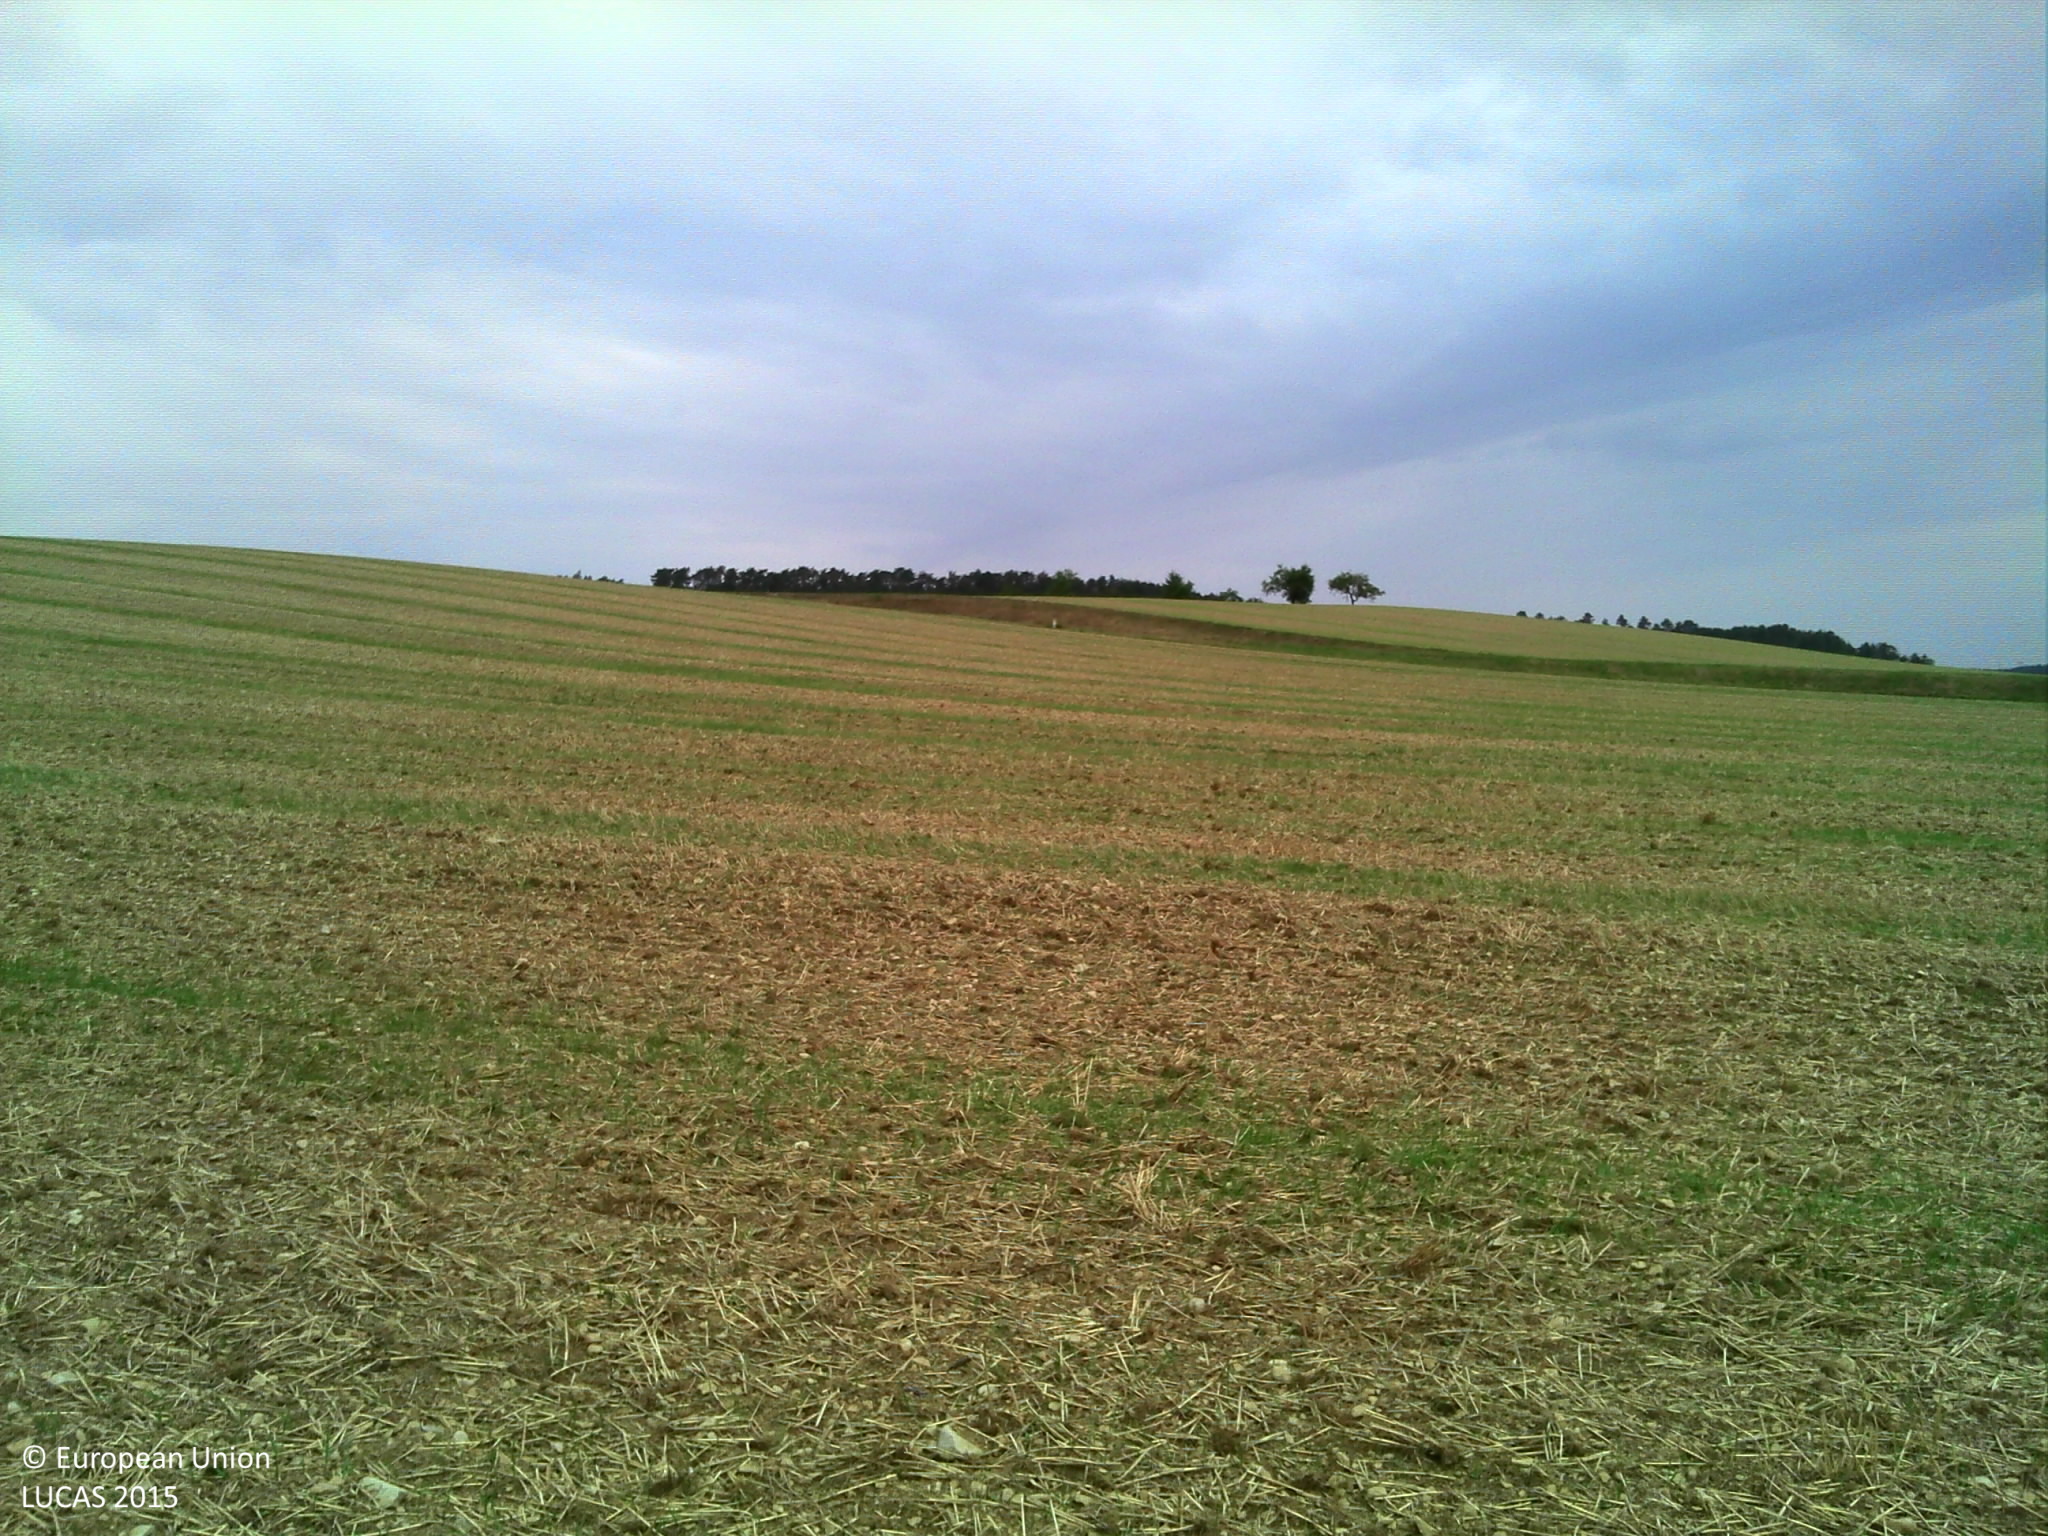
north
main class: Cropland
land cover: Common wheat
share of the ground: 10 - 25 %
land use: Agriculture (excluding fallow land and kitchen gardens)
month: August
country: FR
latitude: 47.8798
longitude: 4.3417
